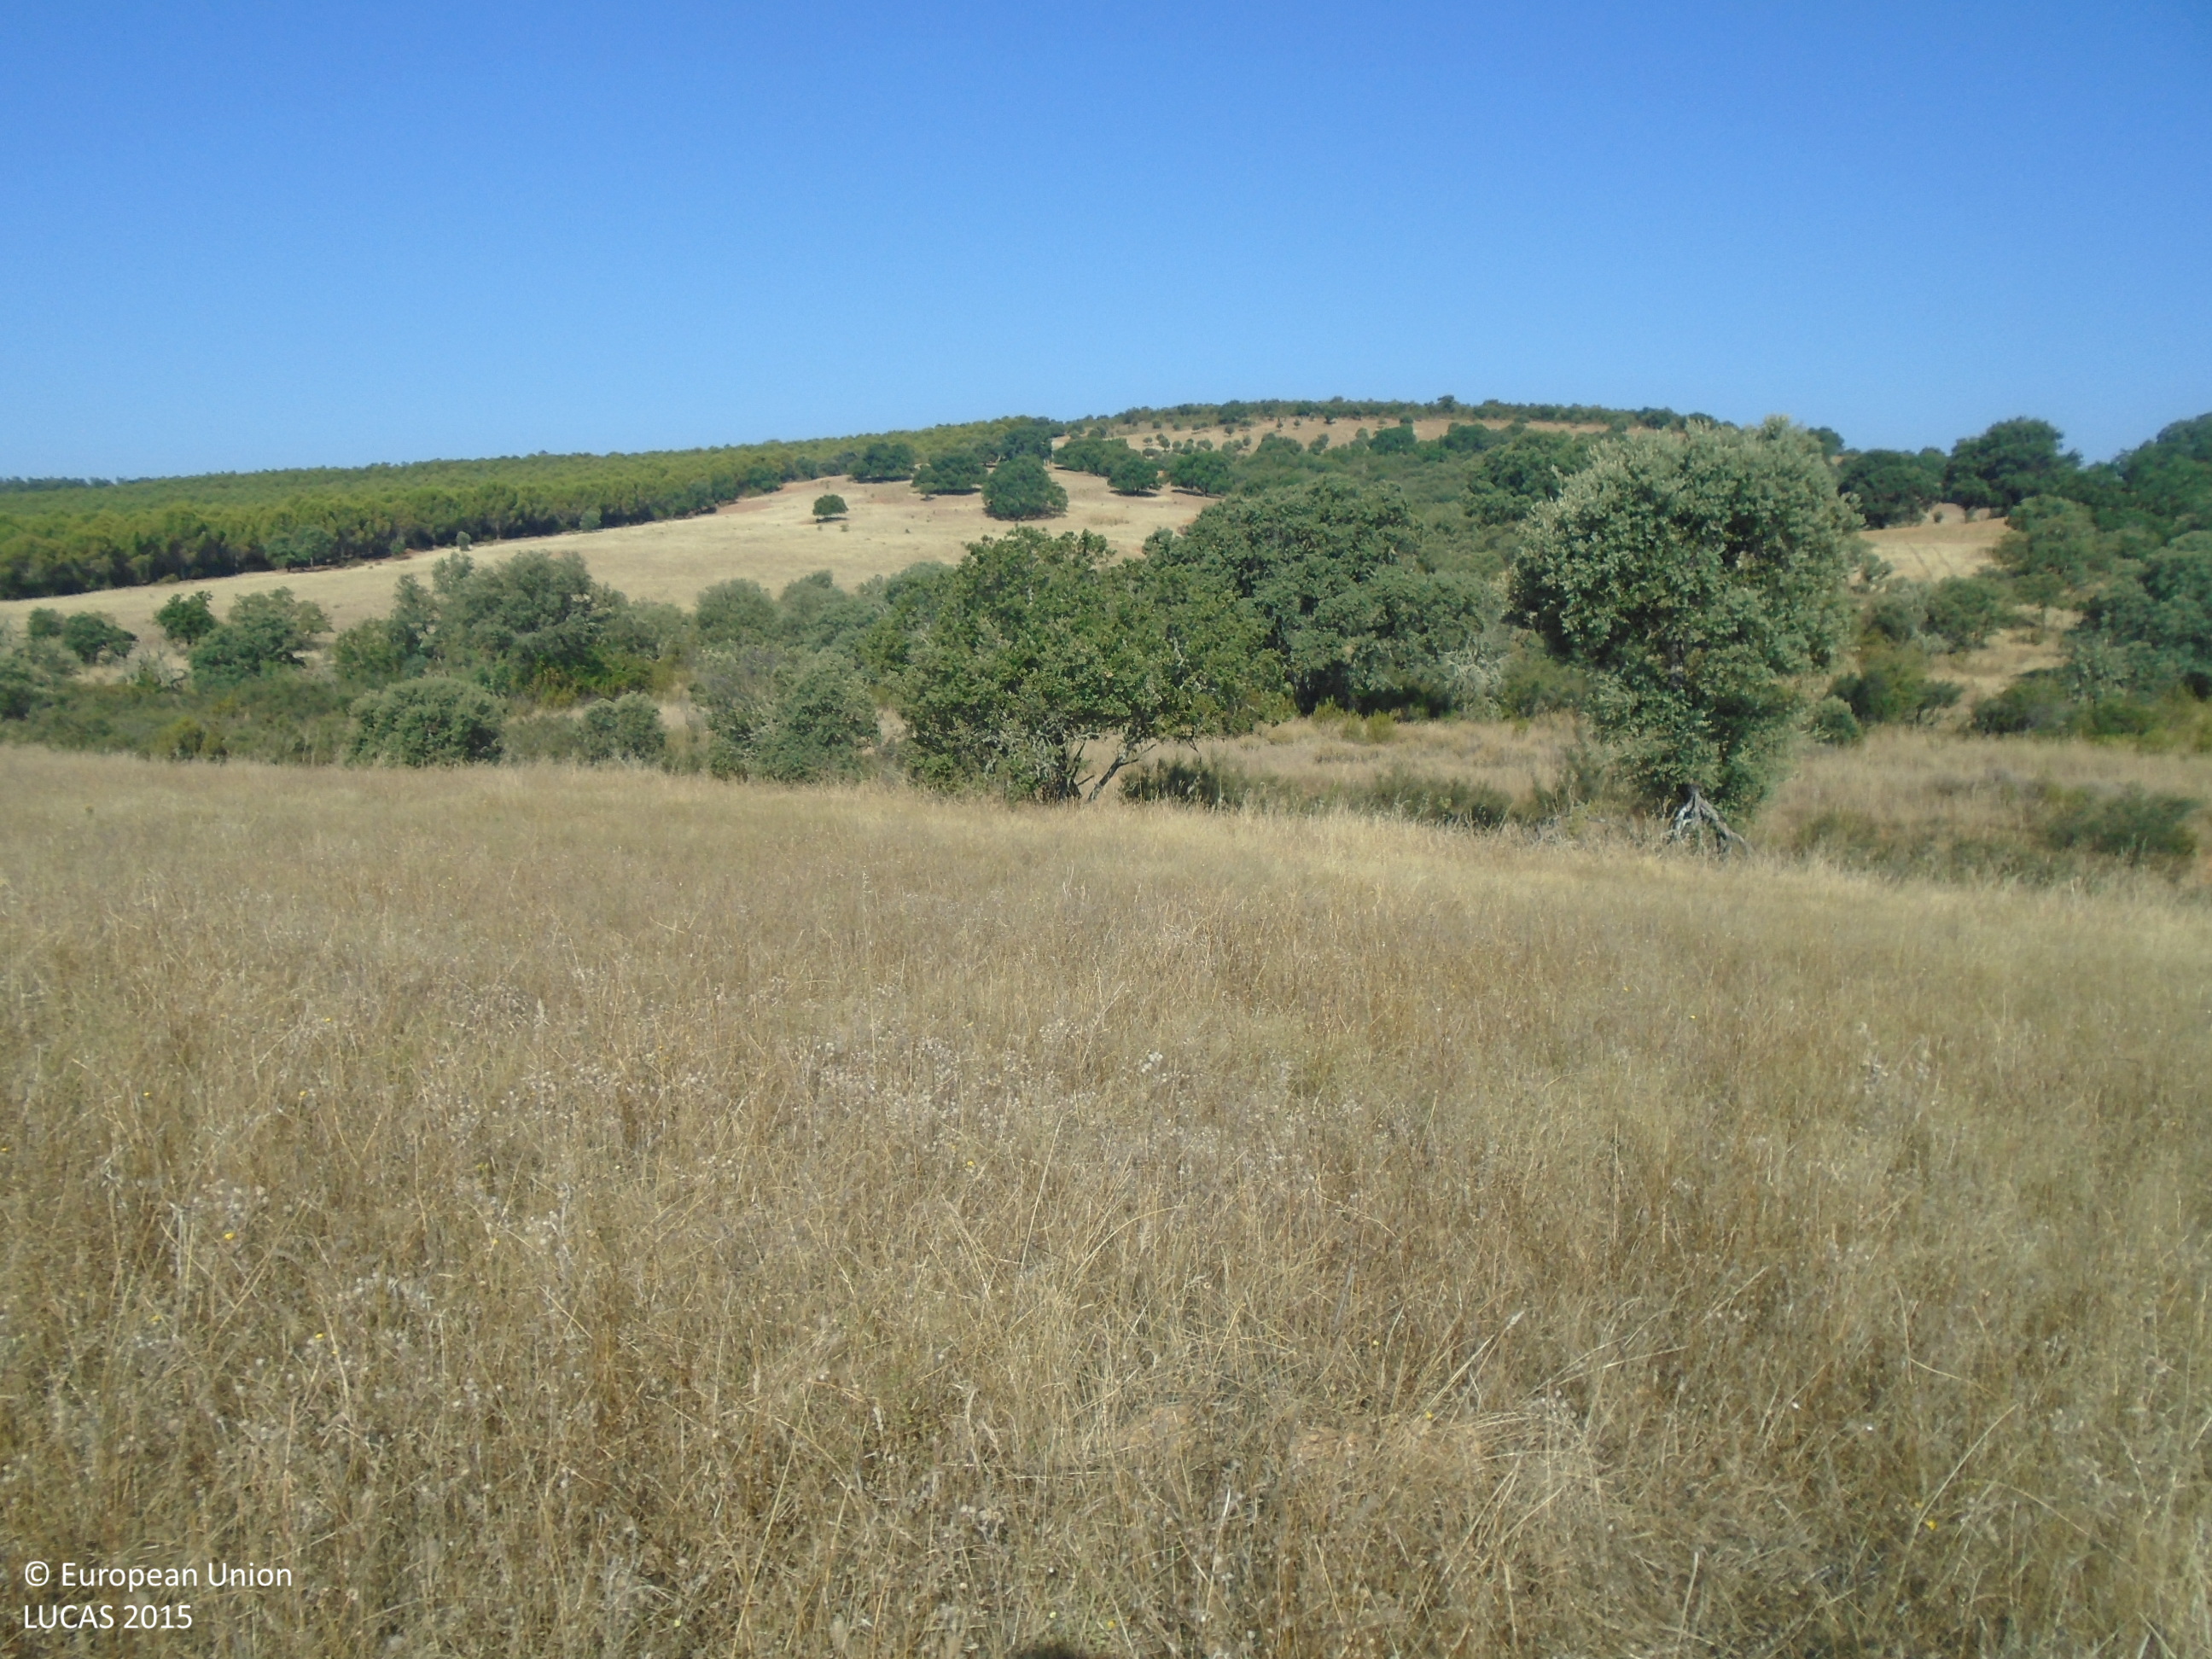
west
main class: Grassland
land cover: Grassland without tree/shrub cover
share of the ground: > 75 %
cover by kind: herbaceous plants 100 %
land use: Agriculture (excluding fallow land and kitchen gardens)
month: July
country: ES
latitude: 39.4204
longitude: -4.8736
